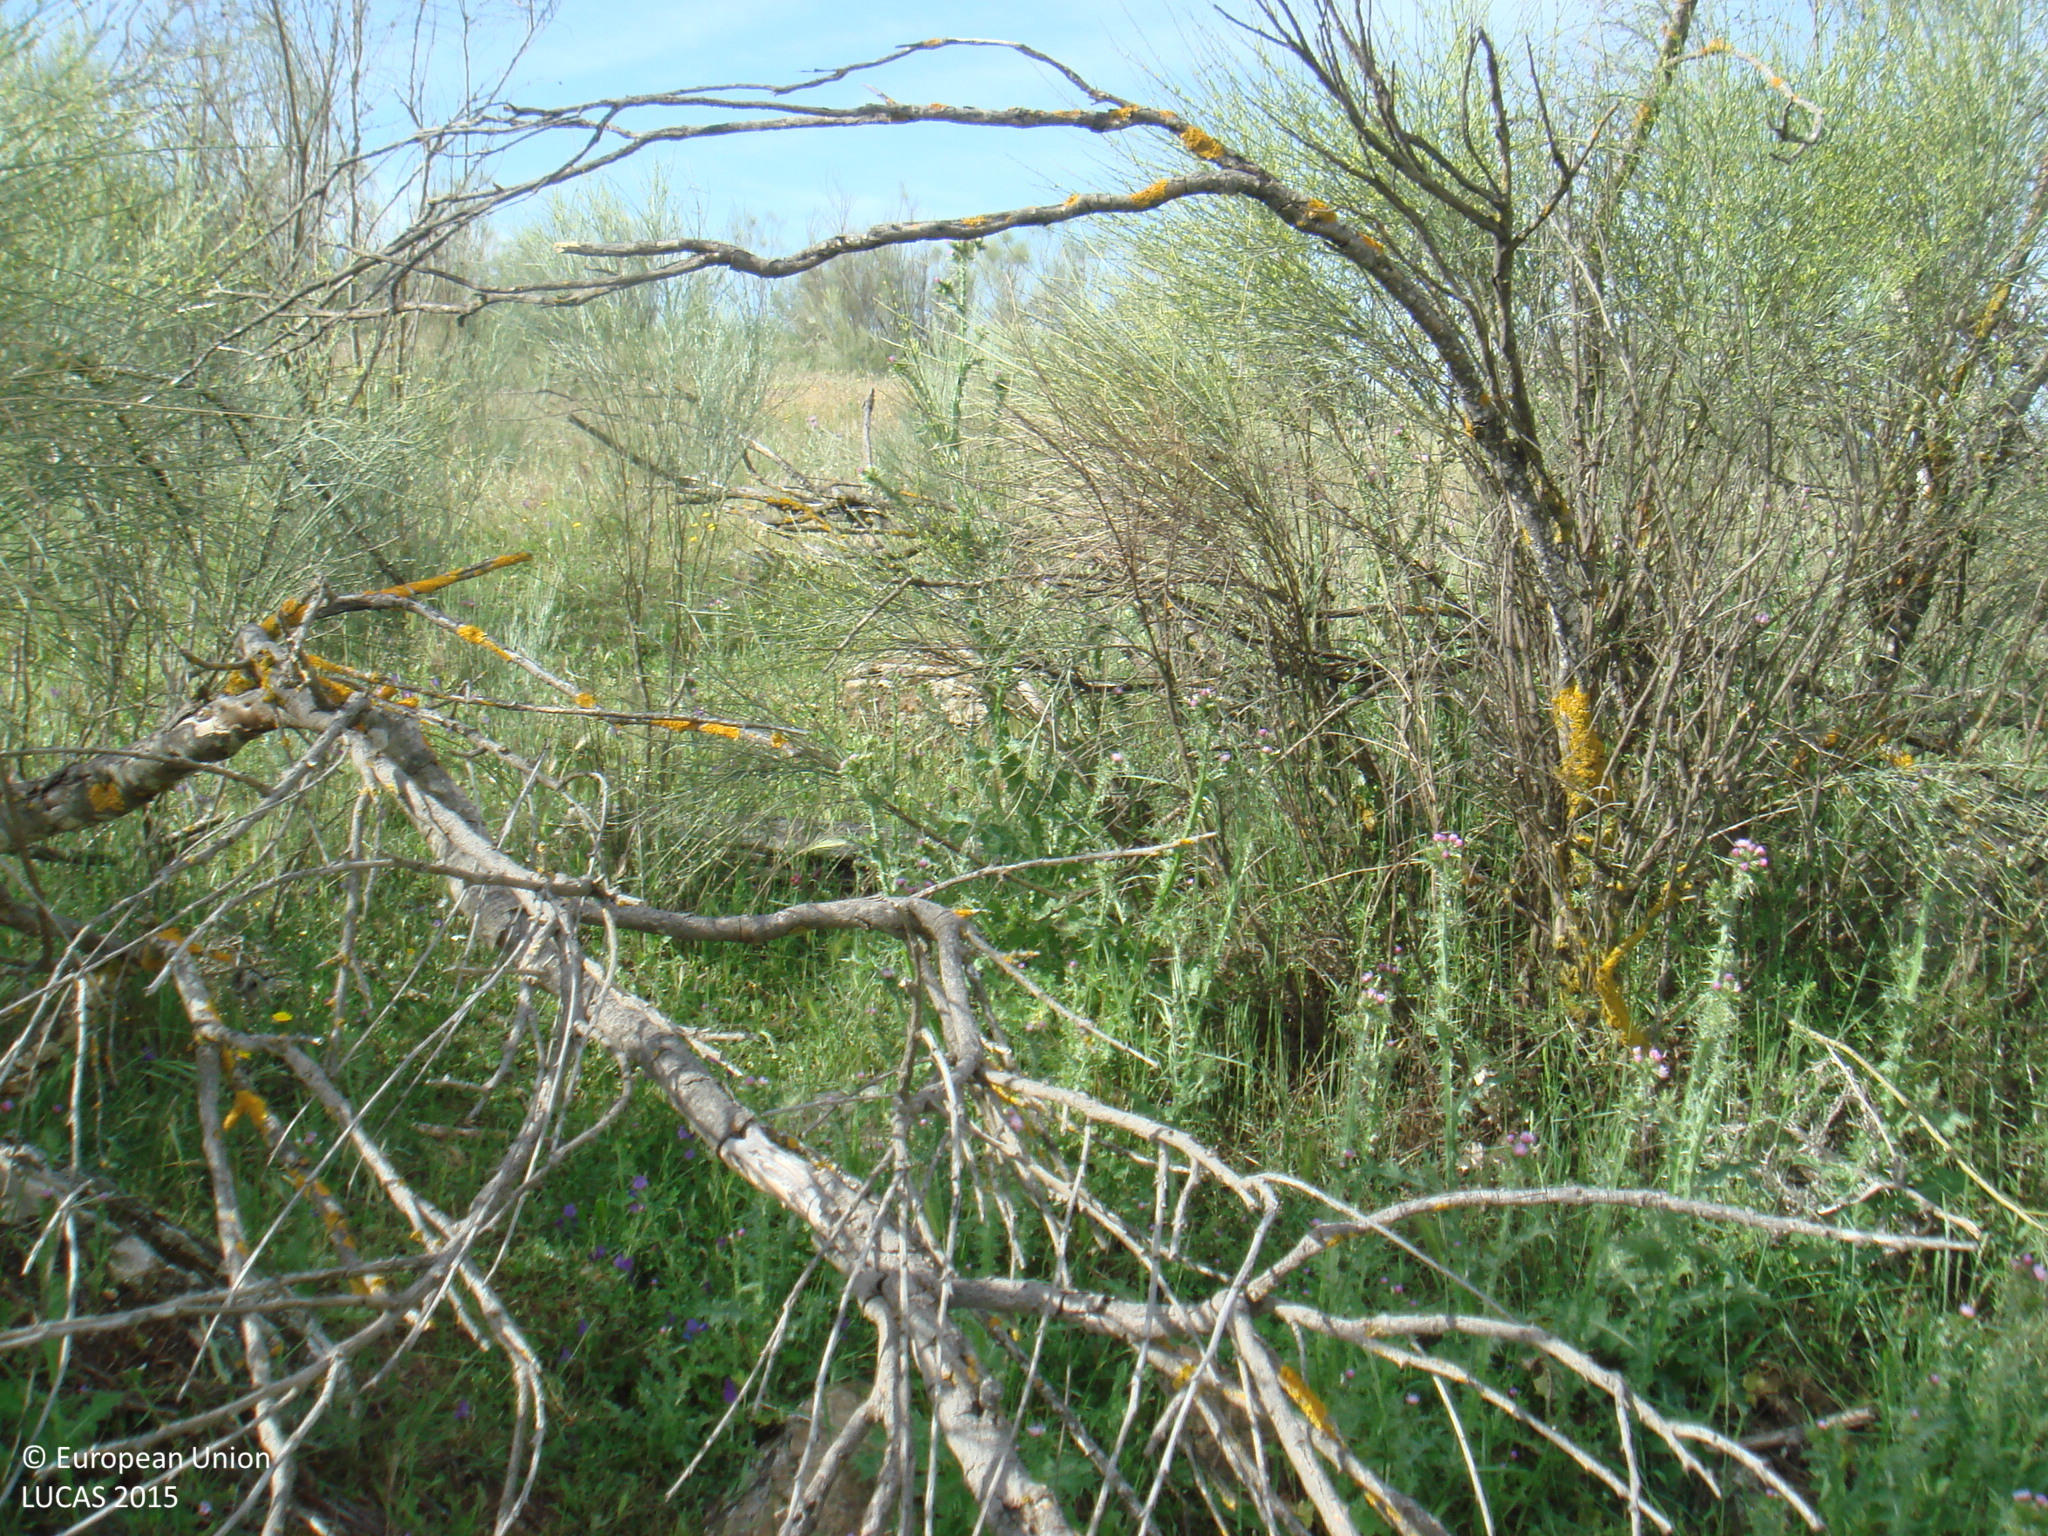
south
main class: Shrubland
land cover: Shrubland without tree cover
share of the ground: > 75 %
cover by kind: herbaceous plants 70 %, shrubs 30 %
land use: Semi-natural and natural areas not in use
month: May
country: ES
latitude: 38.4307
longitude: -5.0917
